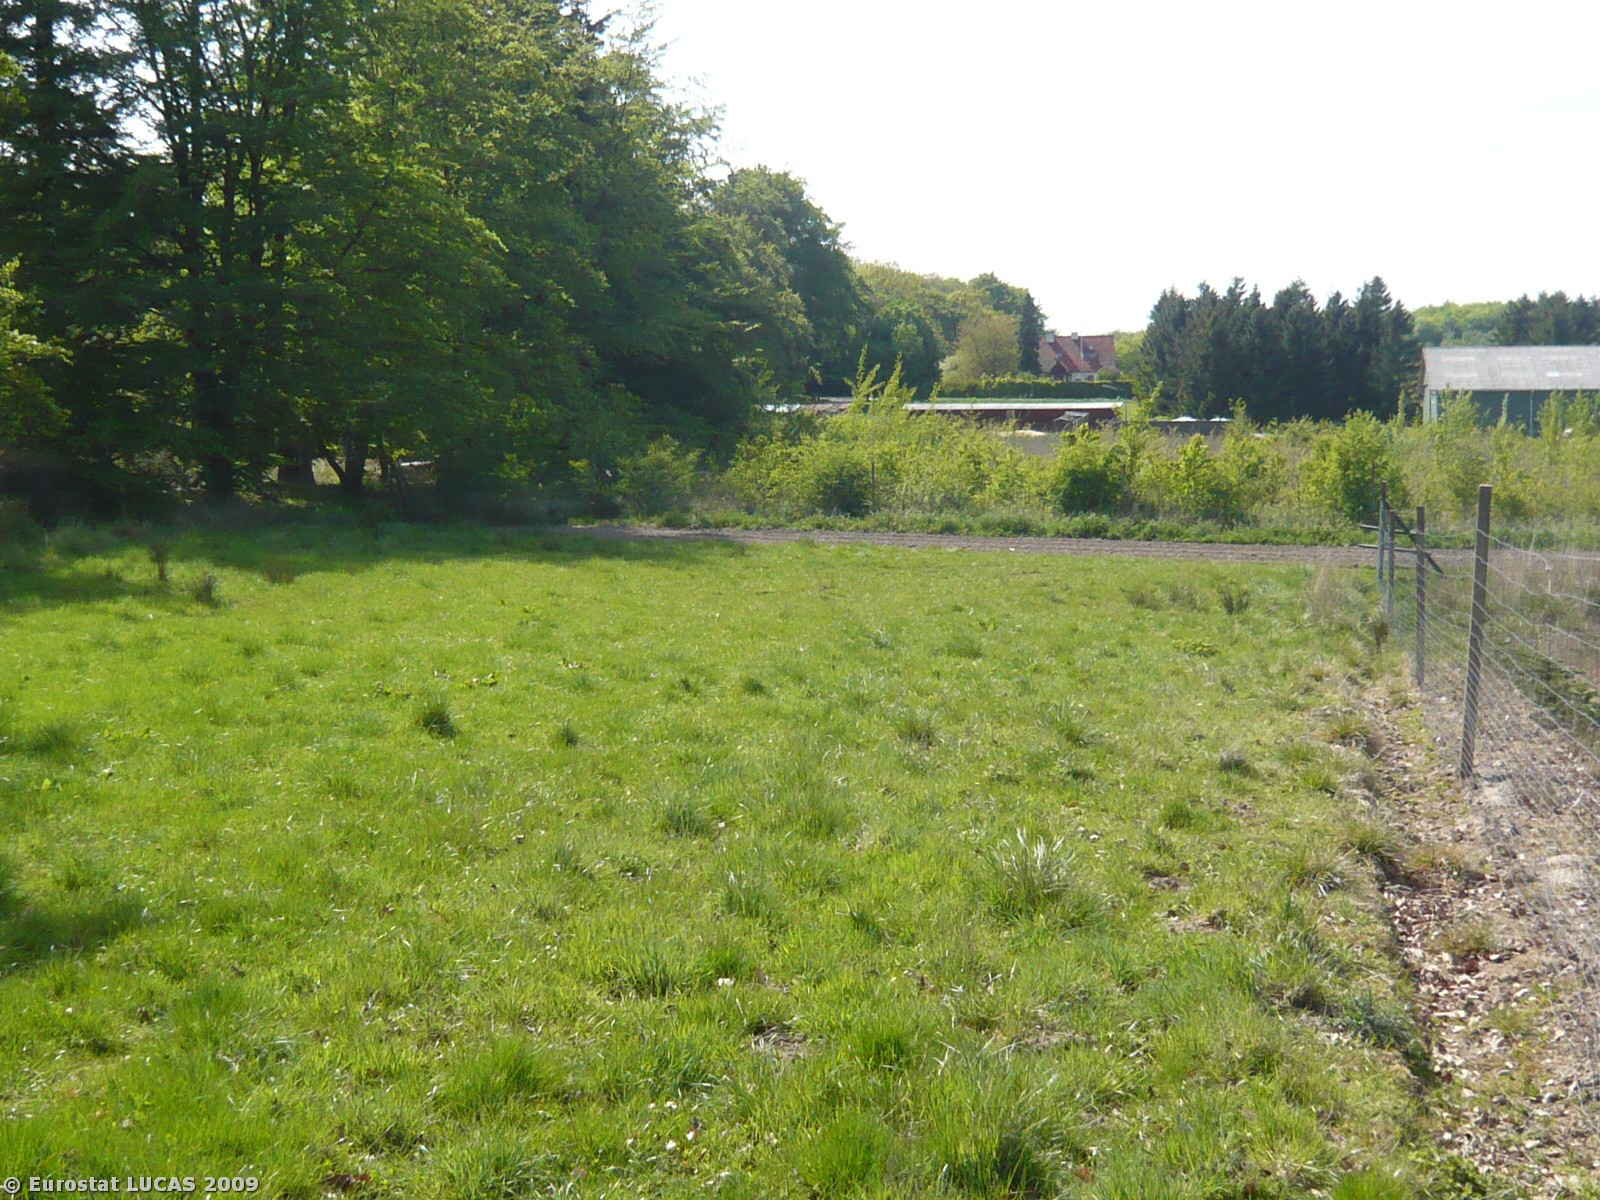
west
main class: Woodland
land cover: Coniferous woodland
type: plantations and self-sown exotic forest
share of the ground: 25 - 50 %
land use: Forestry
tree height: > 5 m
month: May
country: DK
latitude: 55.2557
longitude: 11.9652
